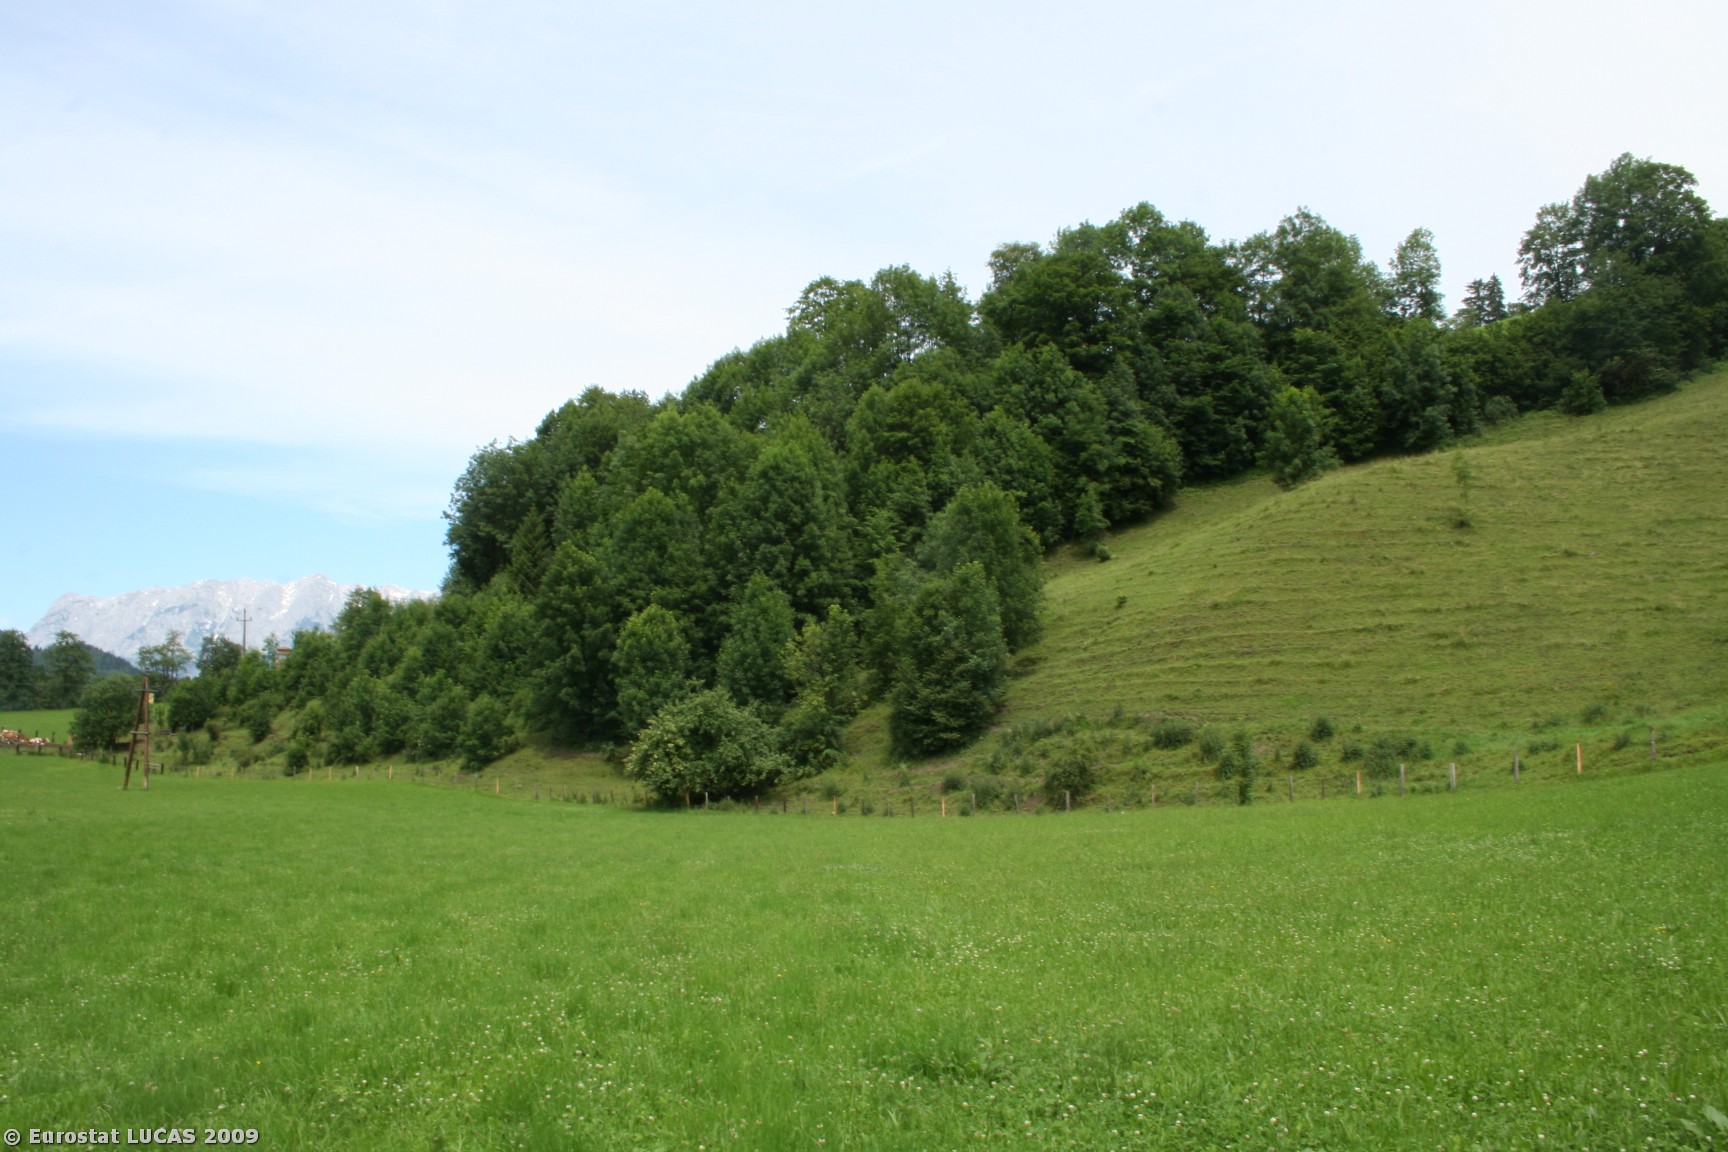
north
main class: Grassland
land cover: Grassland without tree/shrub cover
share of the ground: > 75 %
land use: Agriculture (excluding fallow land and kitchen gardens)
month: June
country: AT
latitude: 47.3661
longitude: 13.2159
